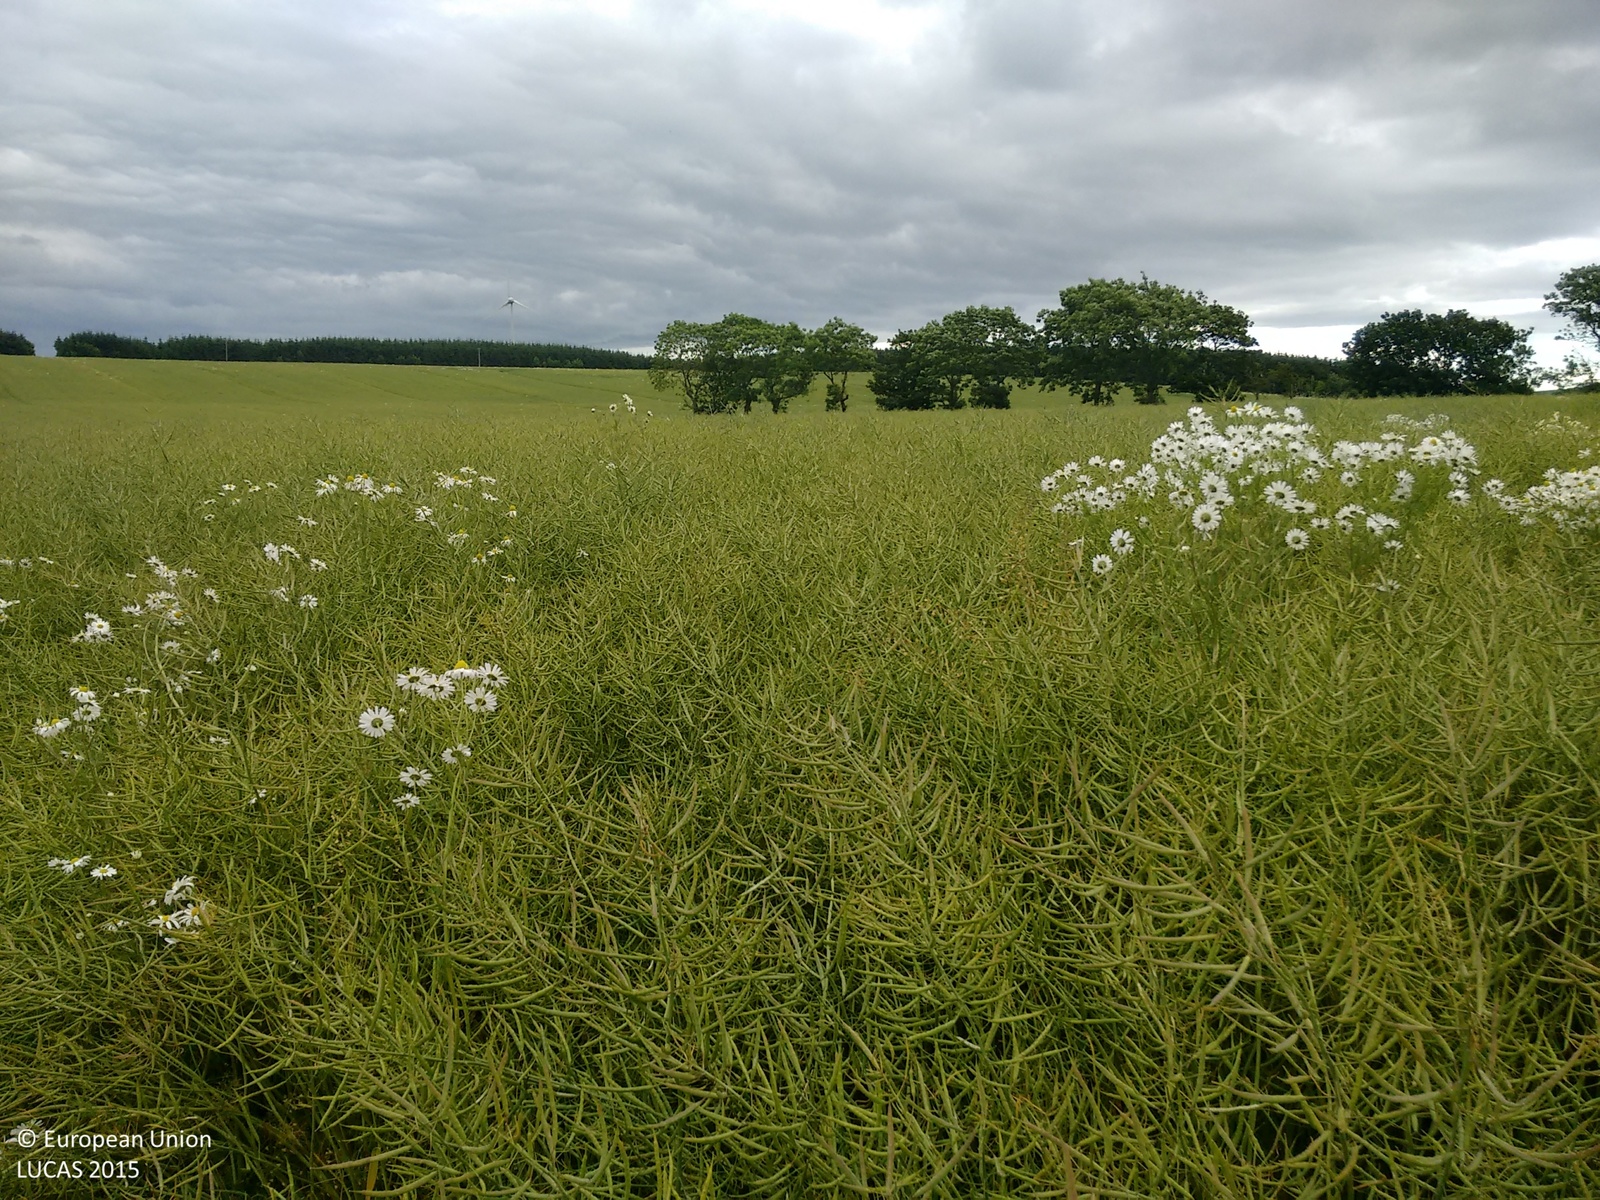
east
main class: Cropland
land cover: Rape and turnip rape
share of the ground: > 75 %
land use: Agriculture (excluding fallow land and kitchen gardens)
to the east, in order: Rape and turnip rape; Grass margins; Dry stone walls; Fences; Lines of trees; Grass margins; Rape and turnip rape
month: July
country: GB
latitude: 57.4996
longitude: -1.9759
